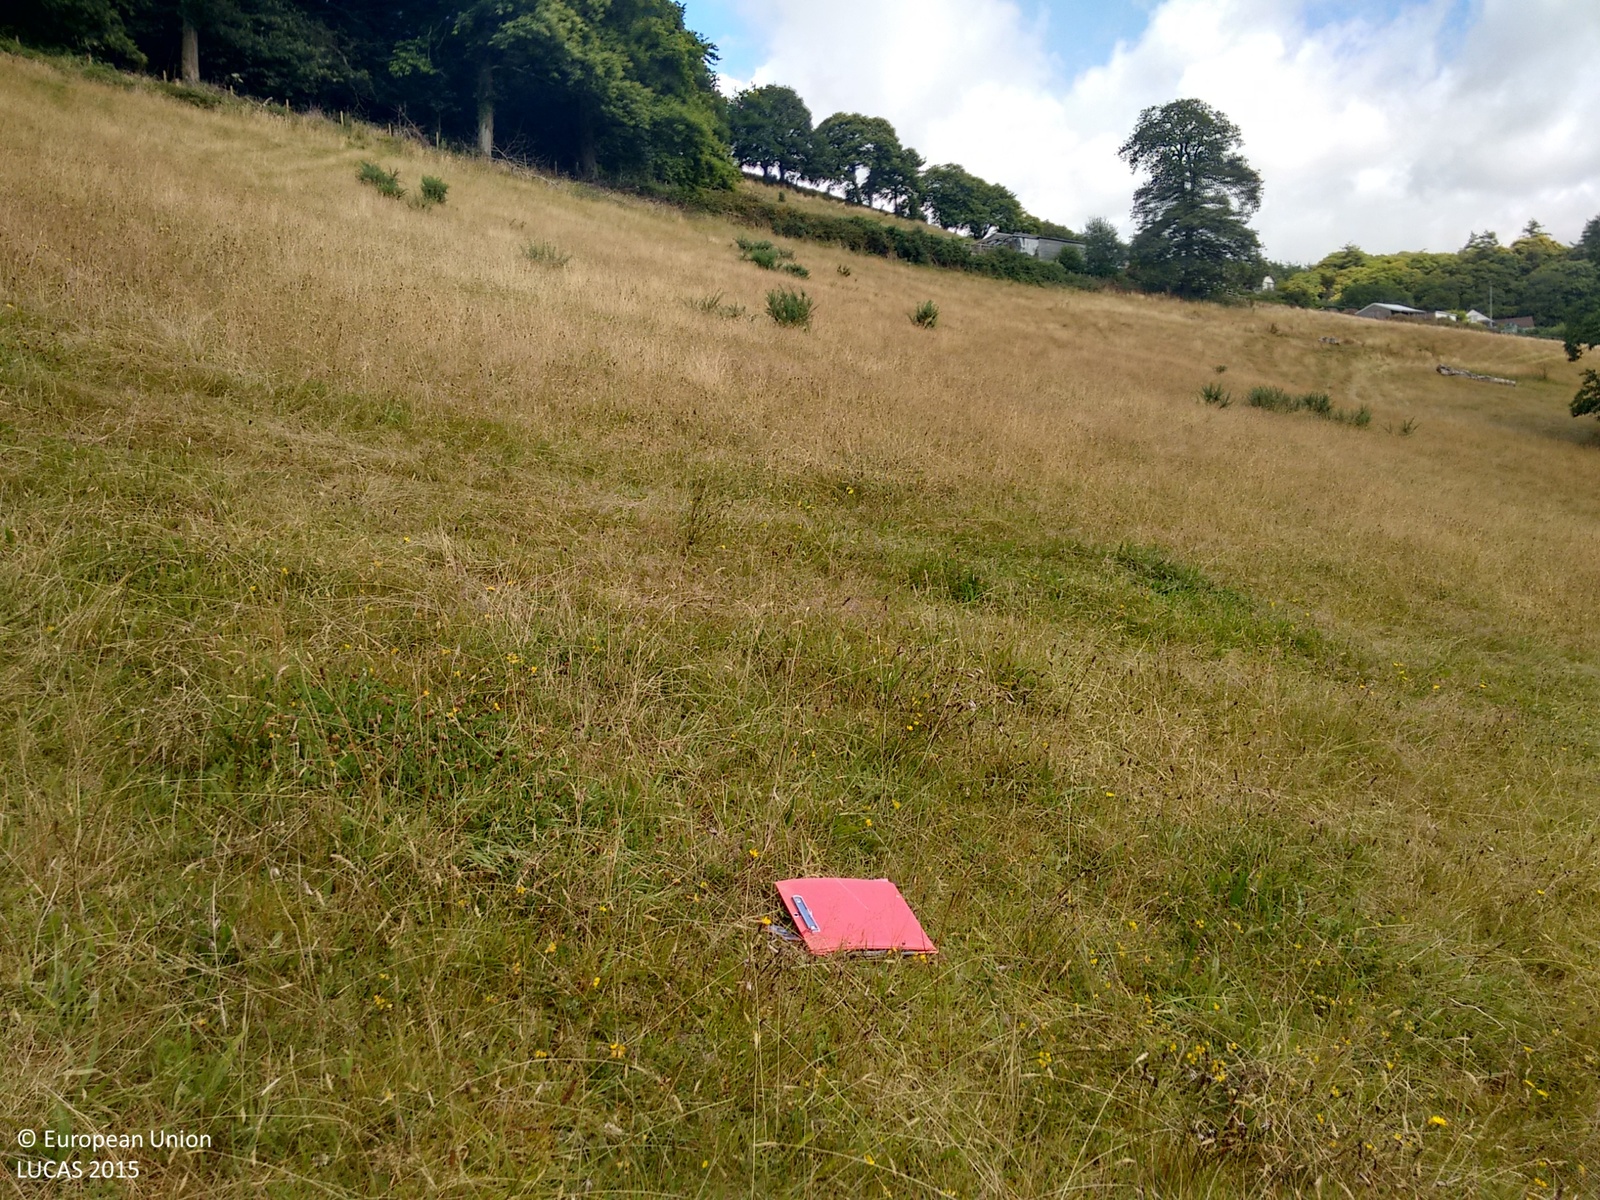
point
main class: Grassland
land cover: Grassland without tree/shrub cover
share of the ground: > 75 %
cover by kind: herbaceous plants 100 %
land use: Agriculture (excluding fallow land and kitchen gardens)
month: August
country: GB
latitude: 50.3162
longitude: -3.7243
